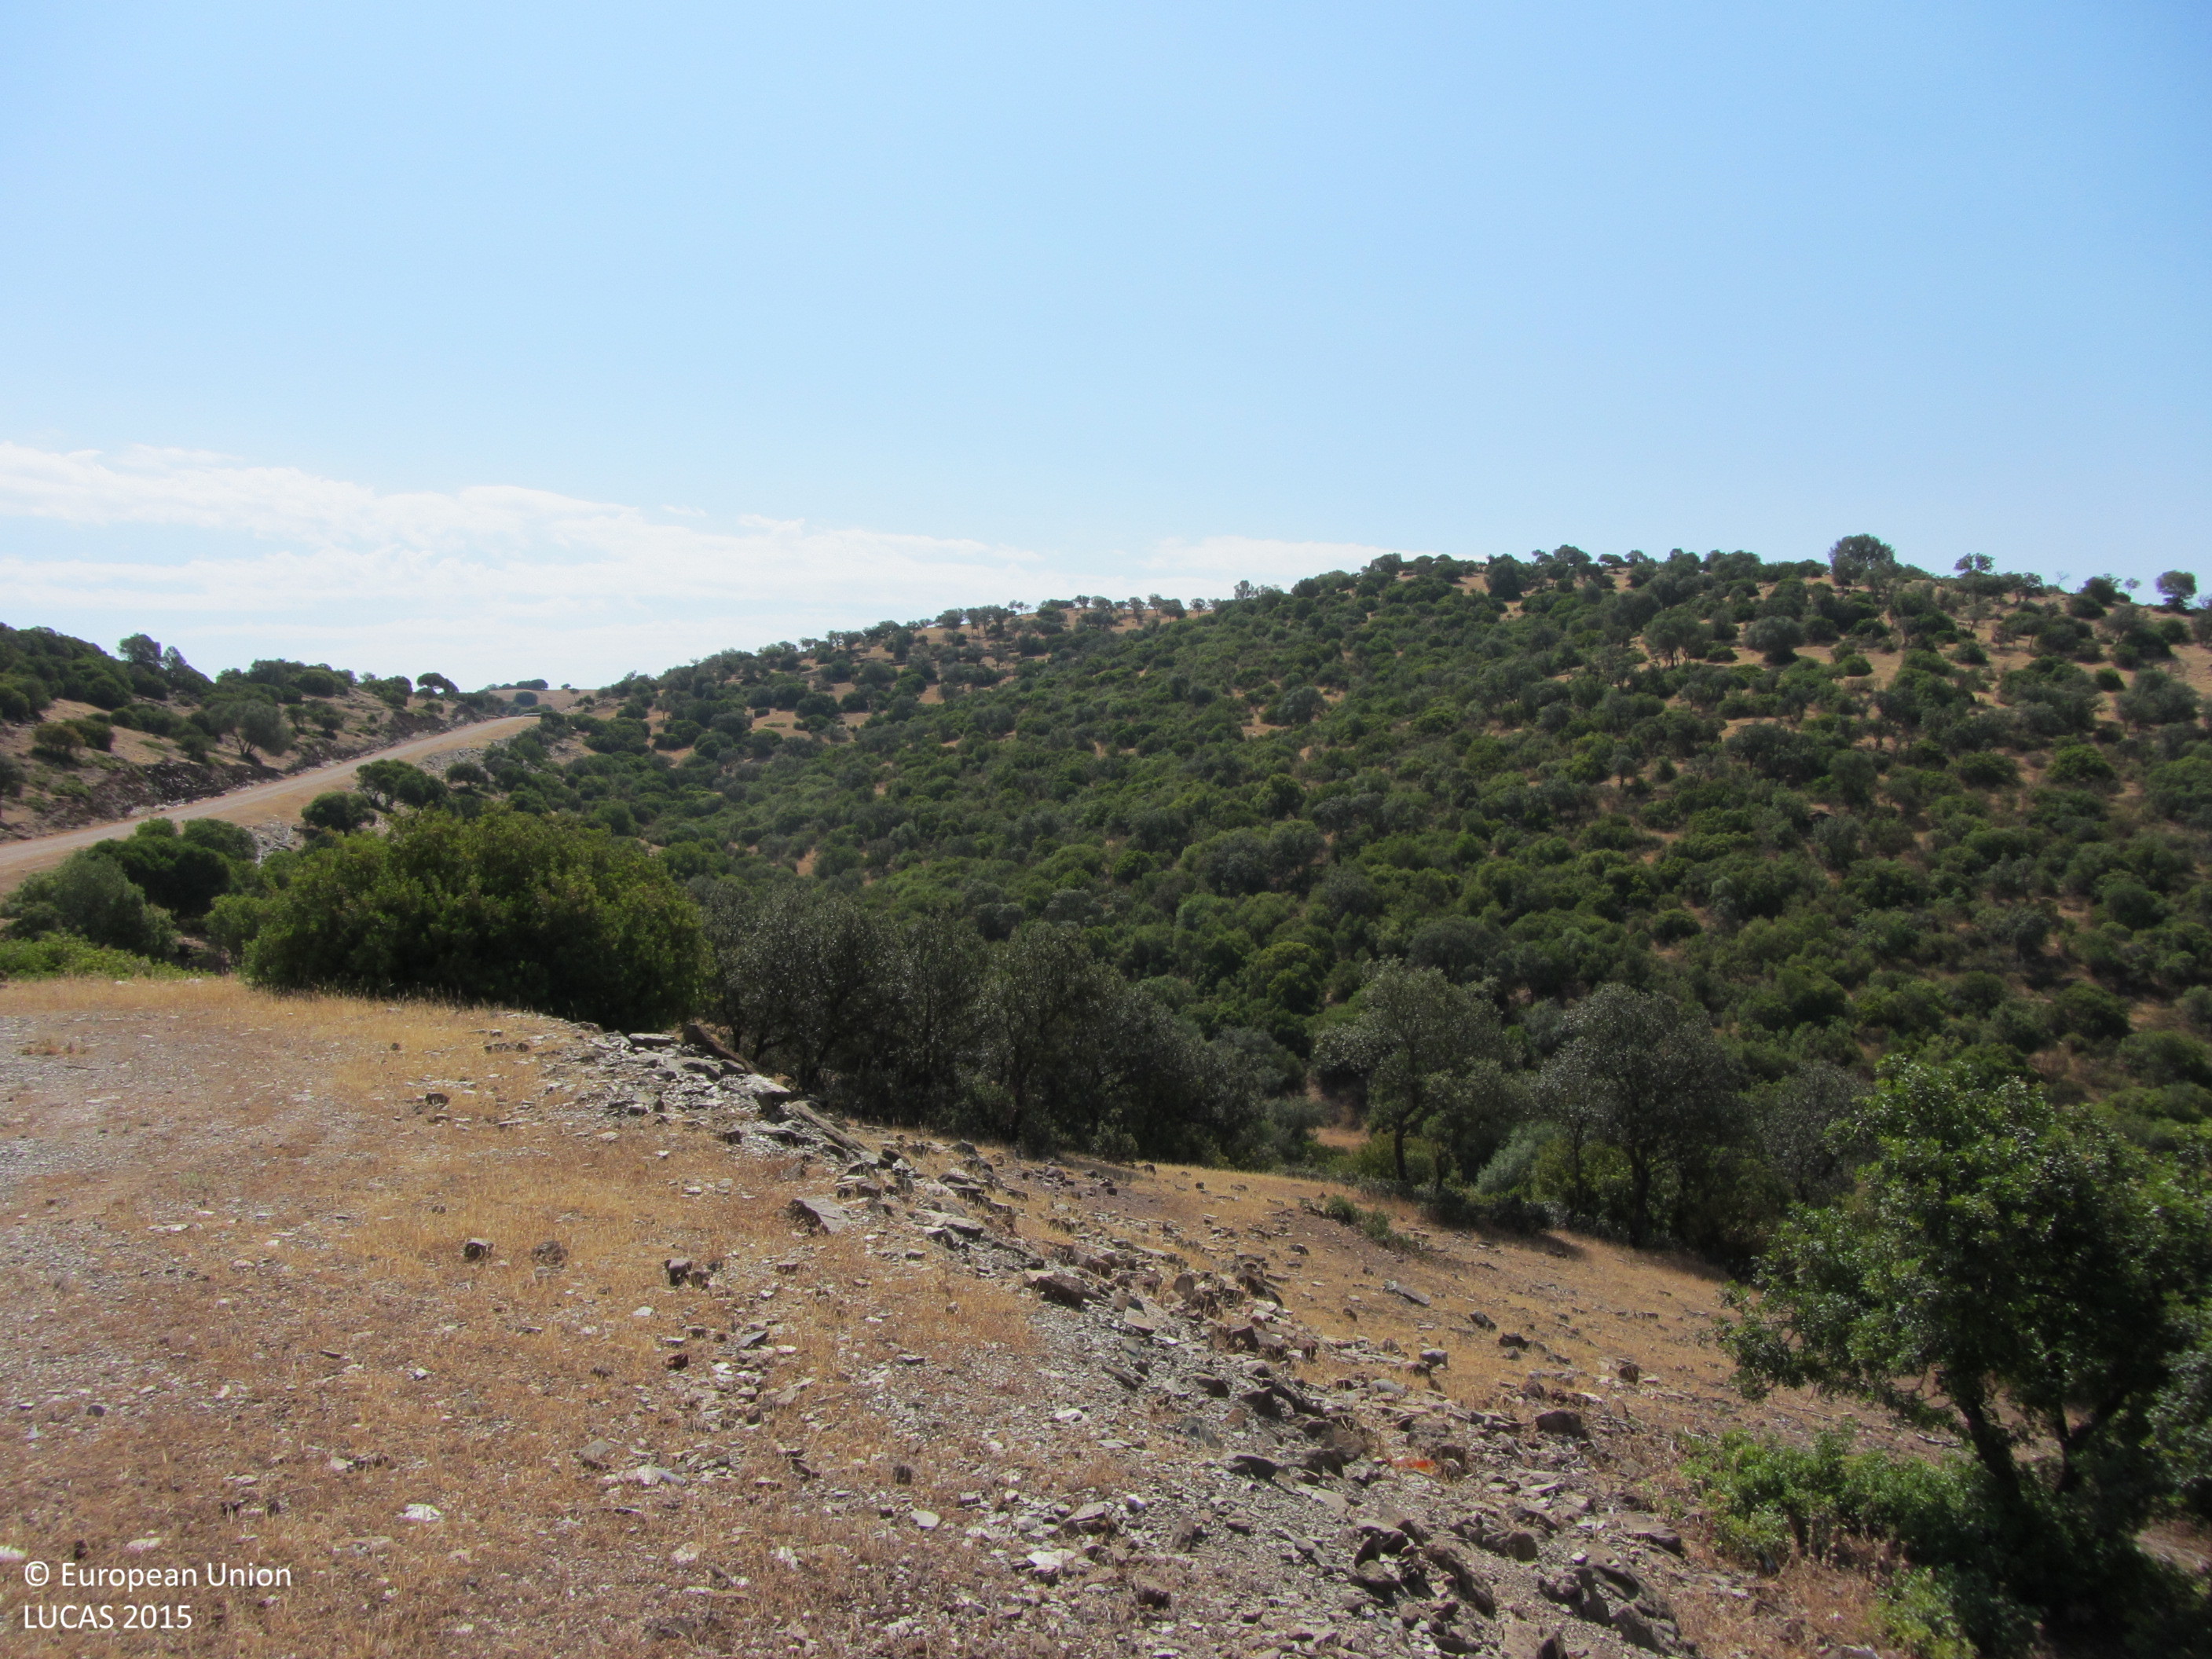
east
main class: Woodland
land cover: Broadleaved woodland
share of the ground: 25 - 50 %
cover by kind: shrubs 45 %, broadleaved forest trees 40 %, herbaceous plants 15 %
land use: Semi-natural and natural areas not in use
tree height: < 5 m
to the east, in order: Broadleaved woodland; Inland fresh running water; Broadleaved woodland
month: June
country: ES
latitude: 38.2431
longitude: -3.4063
